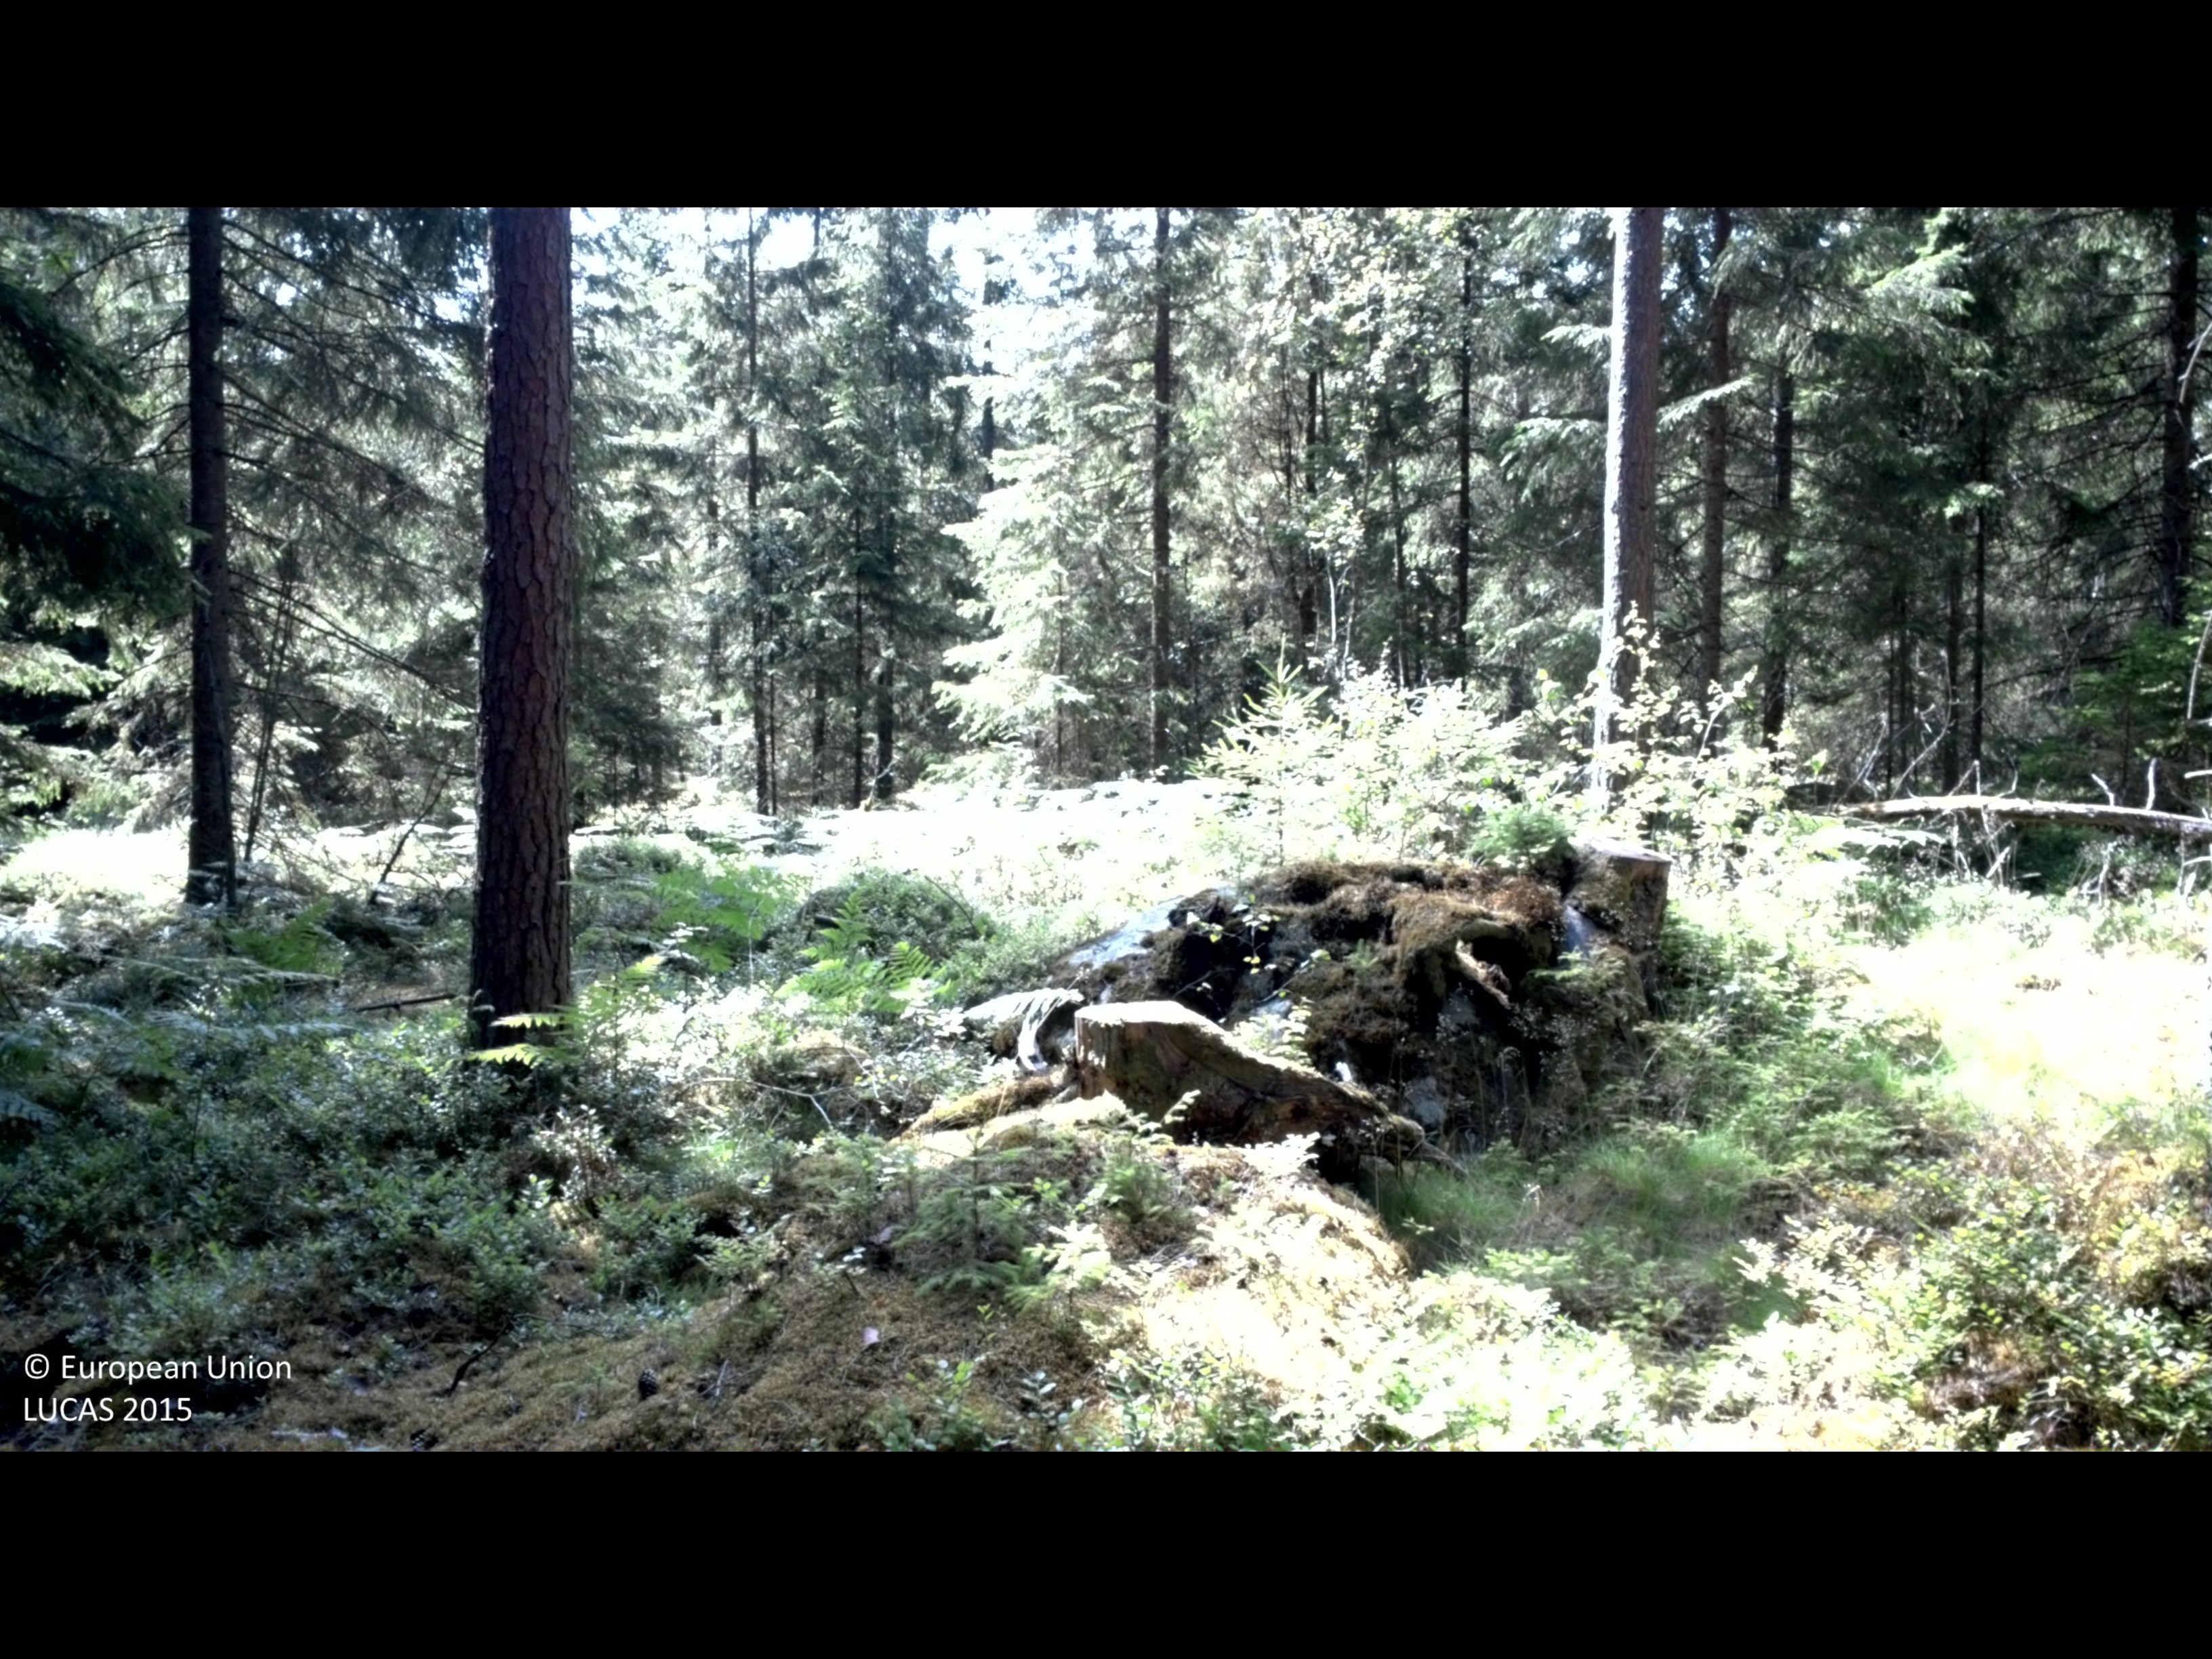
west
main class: Woodland
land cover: Spruce dominated coniferous woodland
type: boreal forest
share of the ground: 50 - 75 %
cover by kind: coniferous forest trees 60 %, lichens and mosses 20 %, shrubs 15 %, herbaceous plants 5 %
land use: Forestry
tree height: > 5 m
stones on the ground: 25 - 50 %
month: July
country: SE
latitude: 56.4850
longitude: 14.5607
